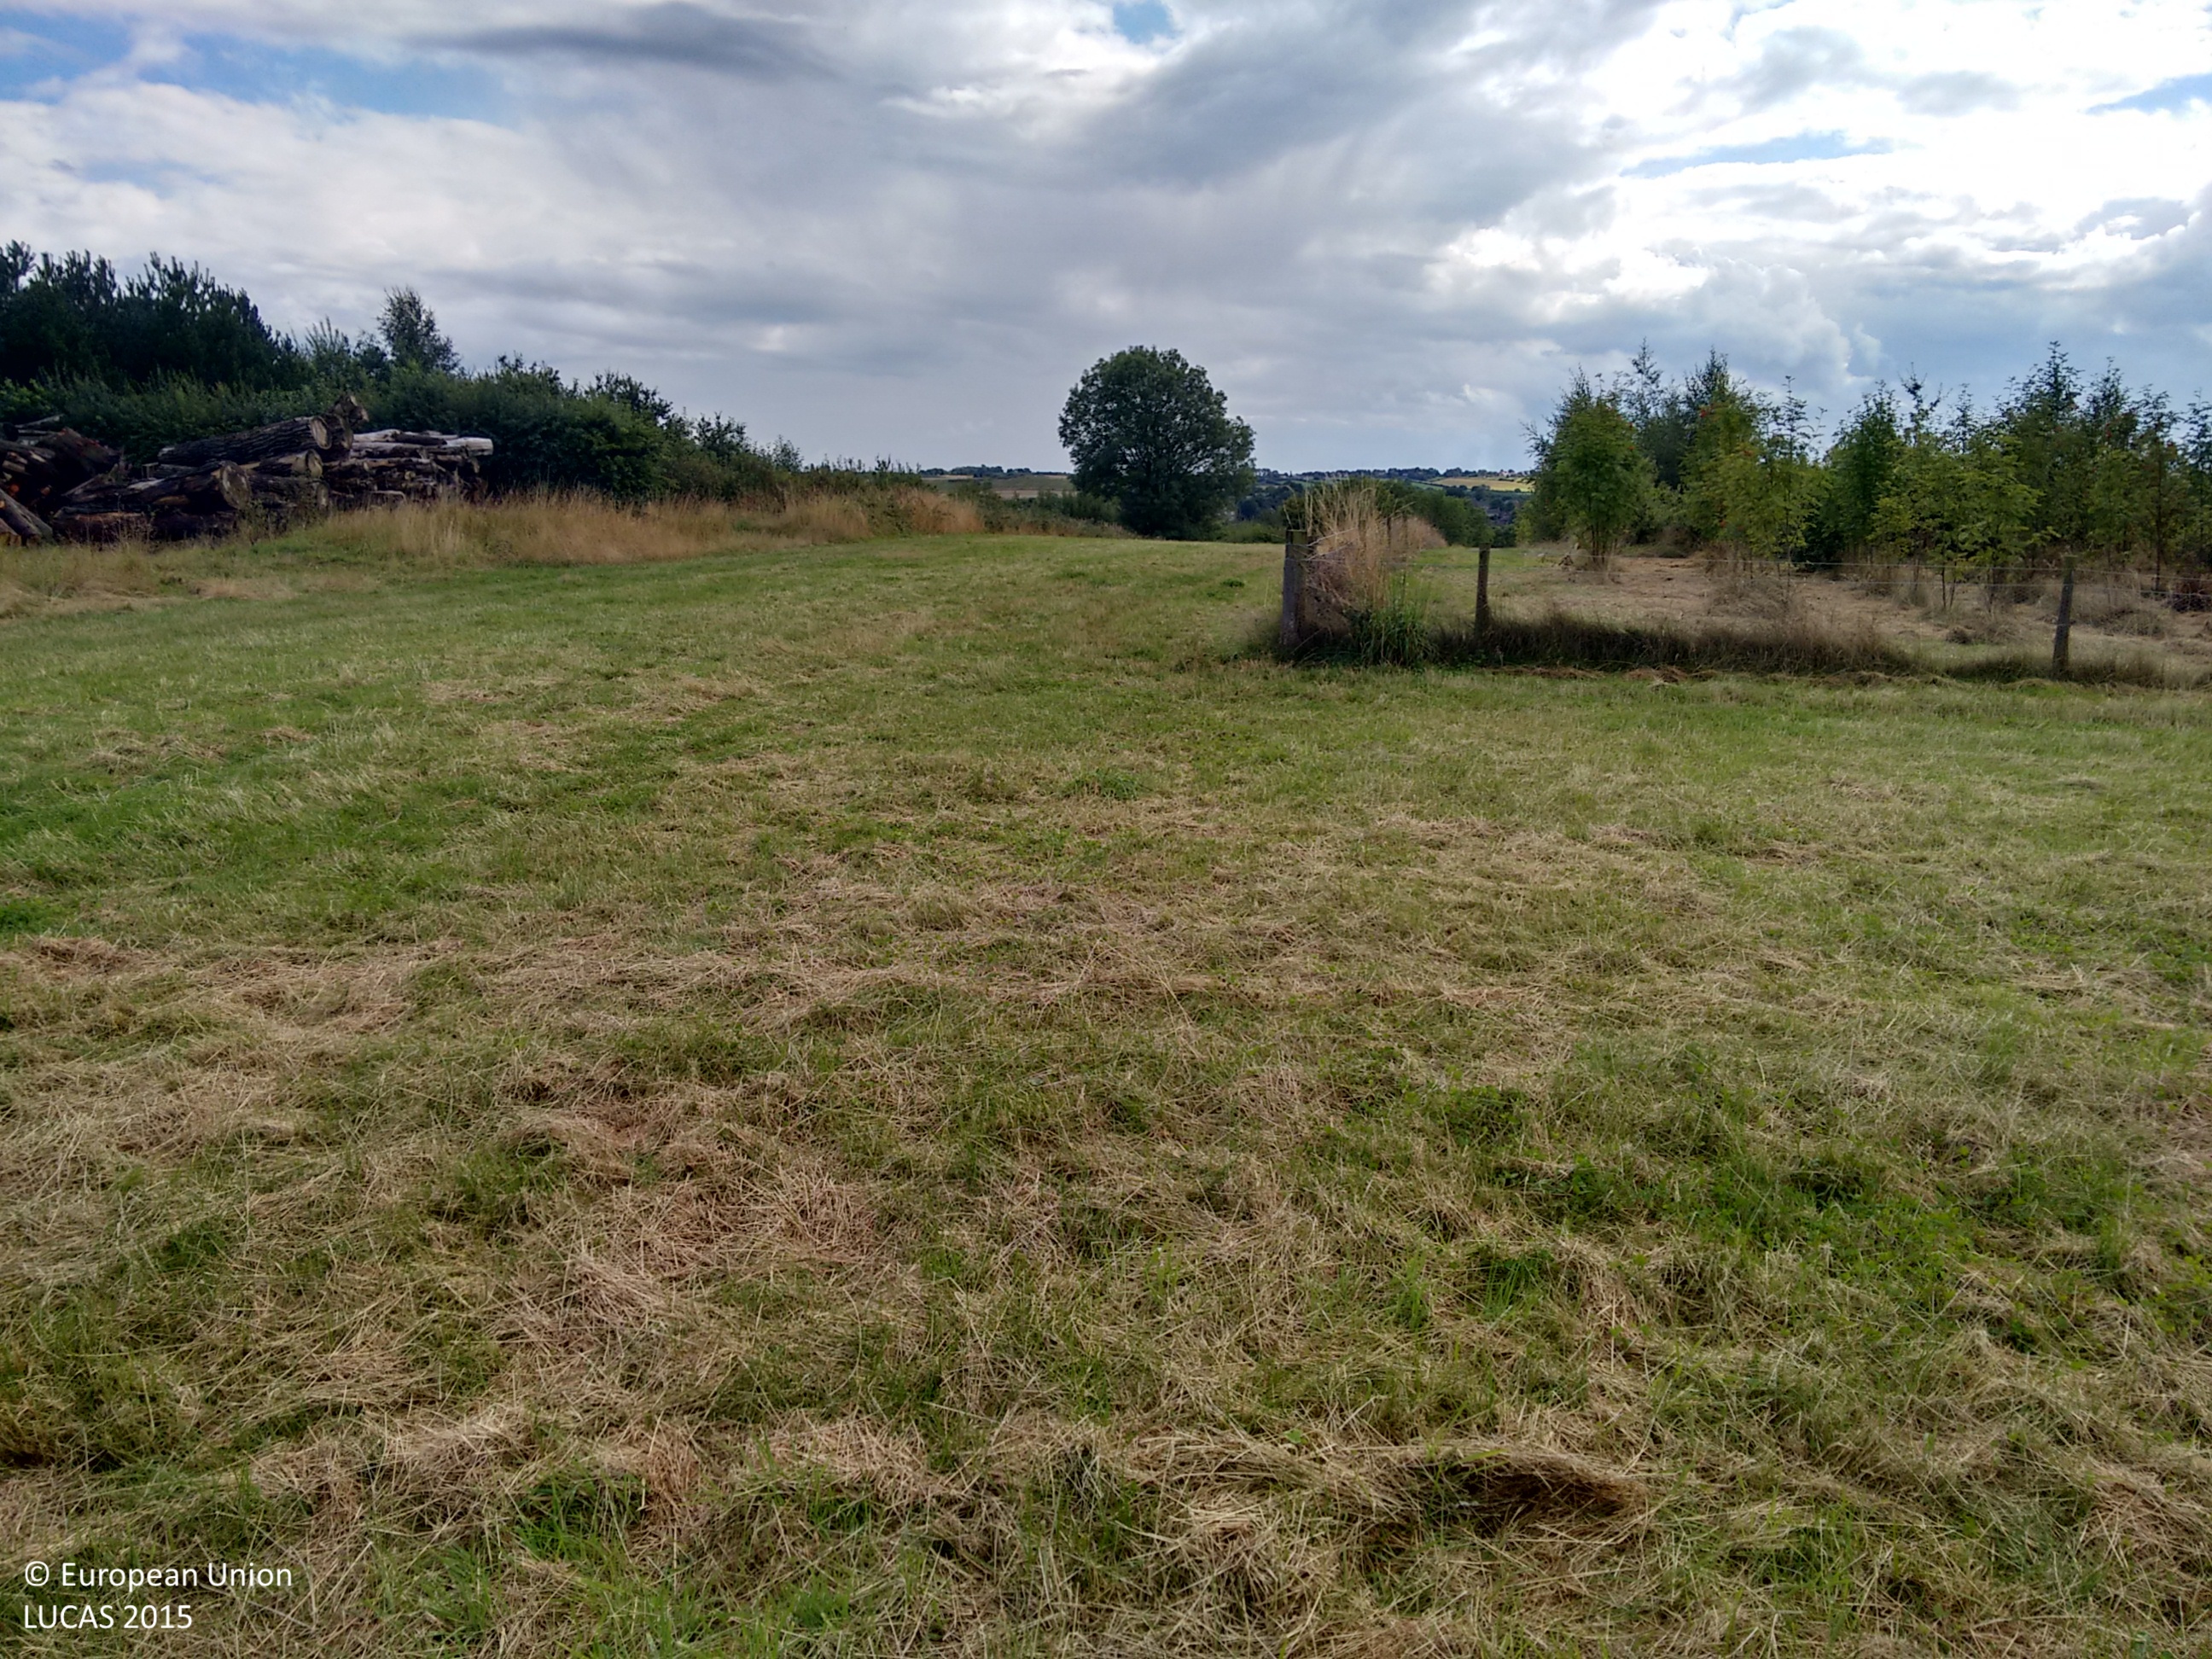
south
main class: Grassland
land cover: Grassland without tree/shrub cover
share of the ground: > 75 %
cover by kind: herbaceous plants 100 %
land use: Agriculture (excluding fallow land and kitchen gardens)
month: September
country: GB
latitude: 52.7960
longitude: -1.5151
